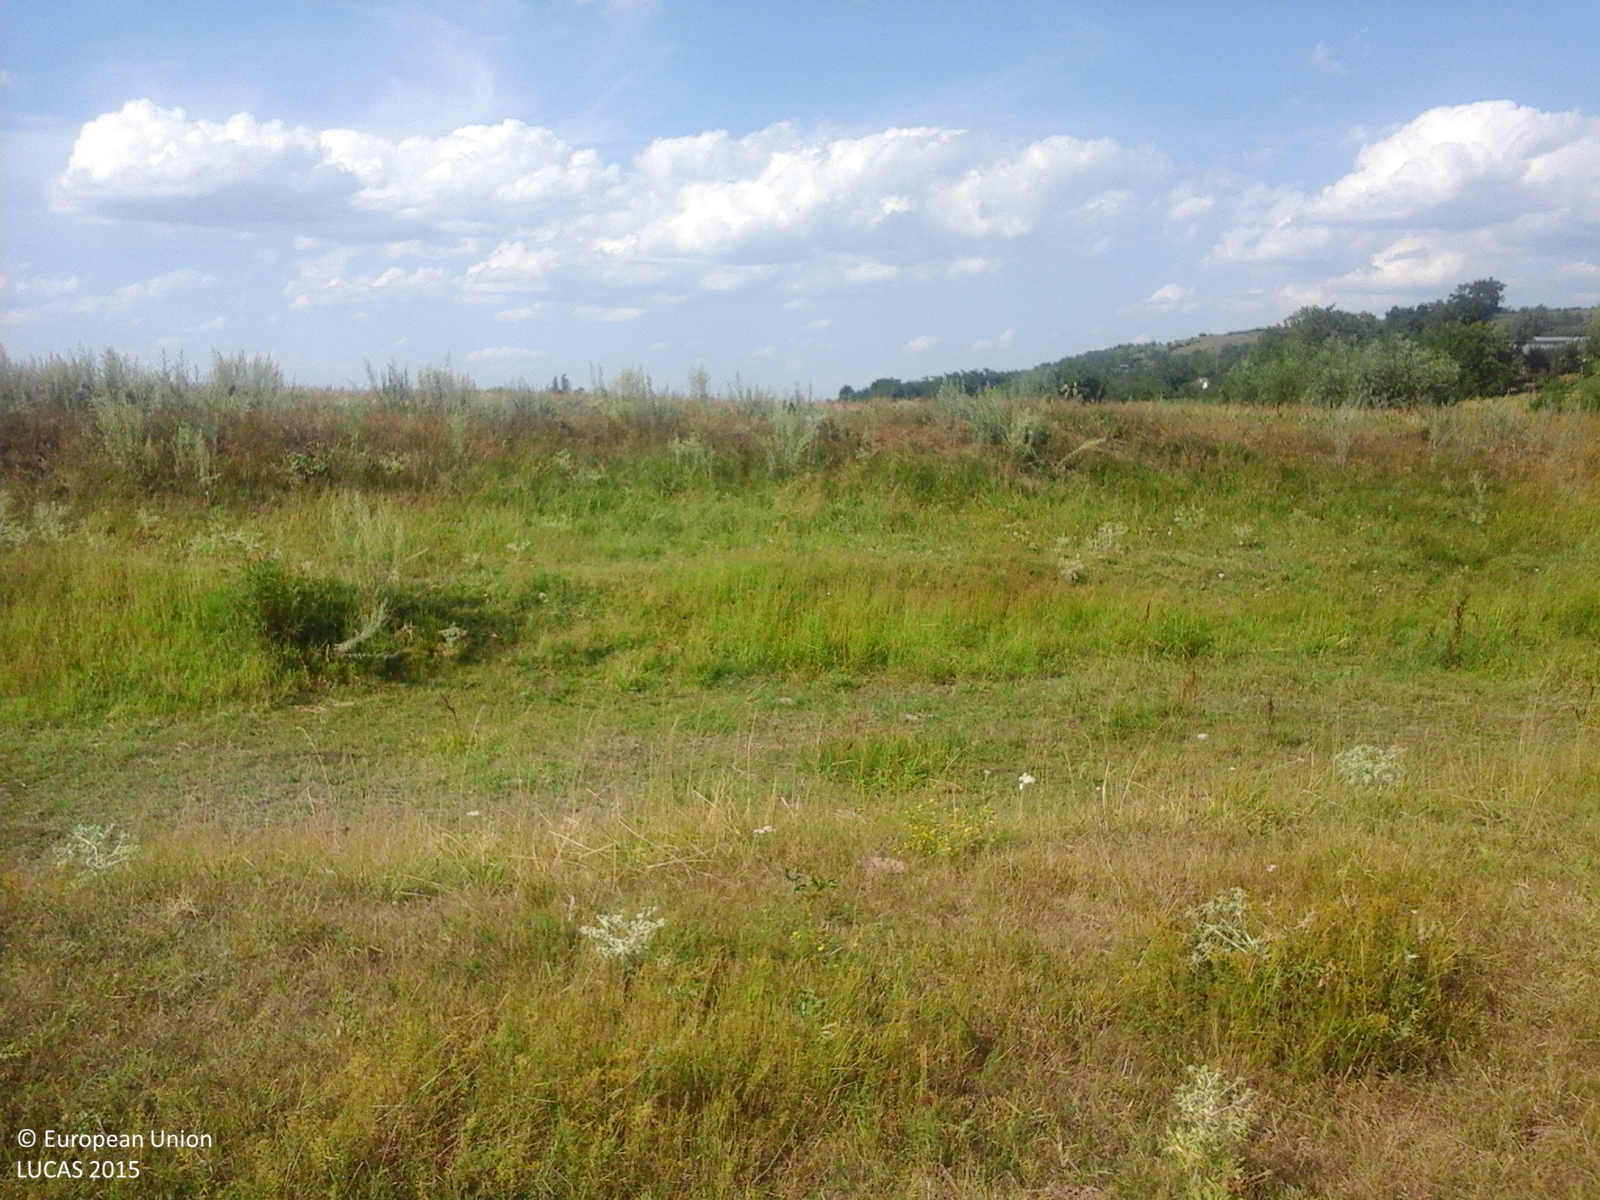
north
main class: Grassland
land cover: Grassland without tree/shrub cover
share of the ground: > 75 %
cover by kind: herbaceous plants 100 %
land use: Agriculture (excluding fallow land and kitchen gardens)
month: July
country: RO
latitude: 46.4963
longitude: 27.8278
